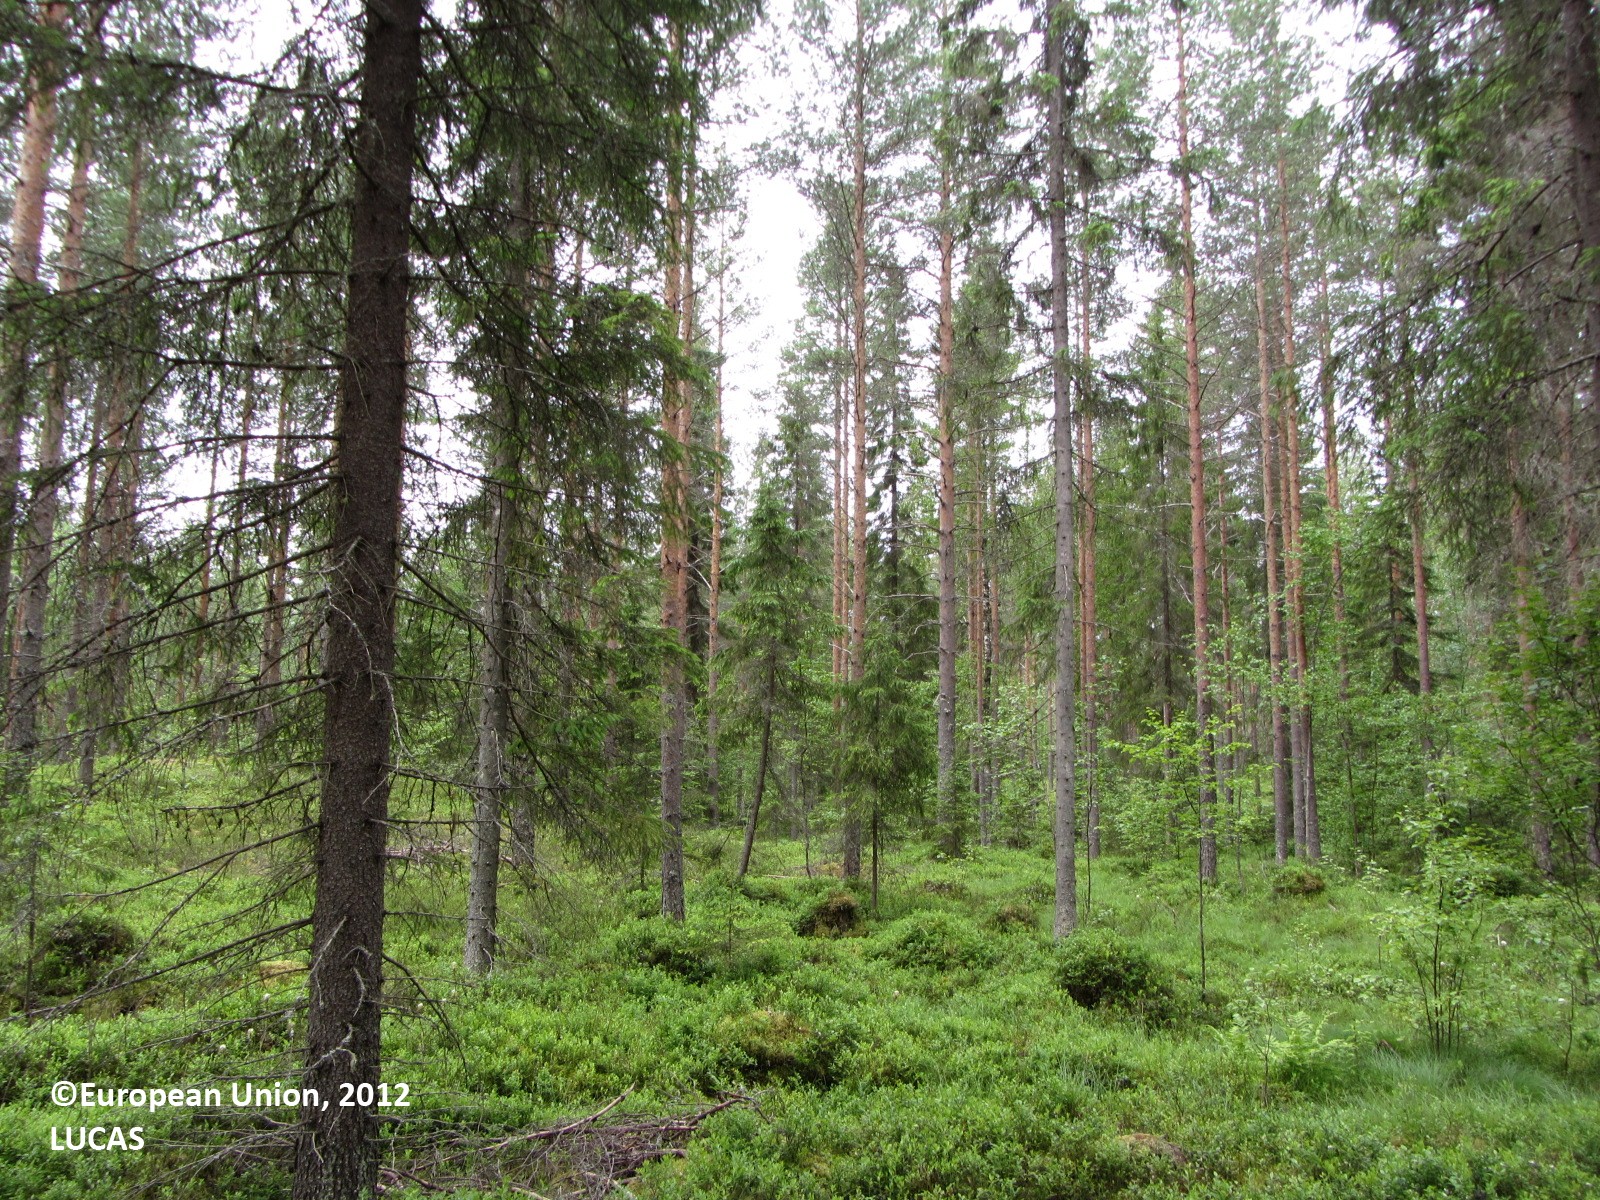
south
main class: Woodland
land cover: Spruce dominated mixed woodland
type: boreal forest
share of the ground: 50 - 75 %
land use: Forestry
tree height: > 5 m
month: June
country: FI
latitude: 62.5864
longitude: 25.2320
